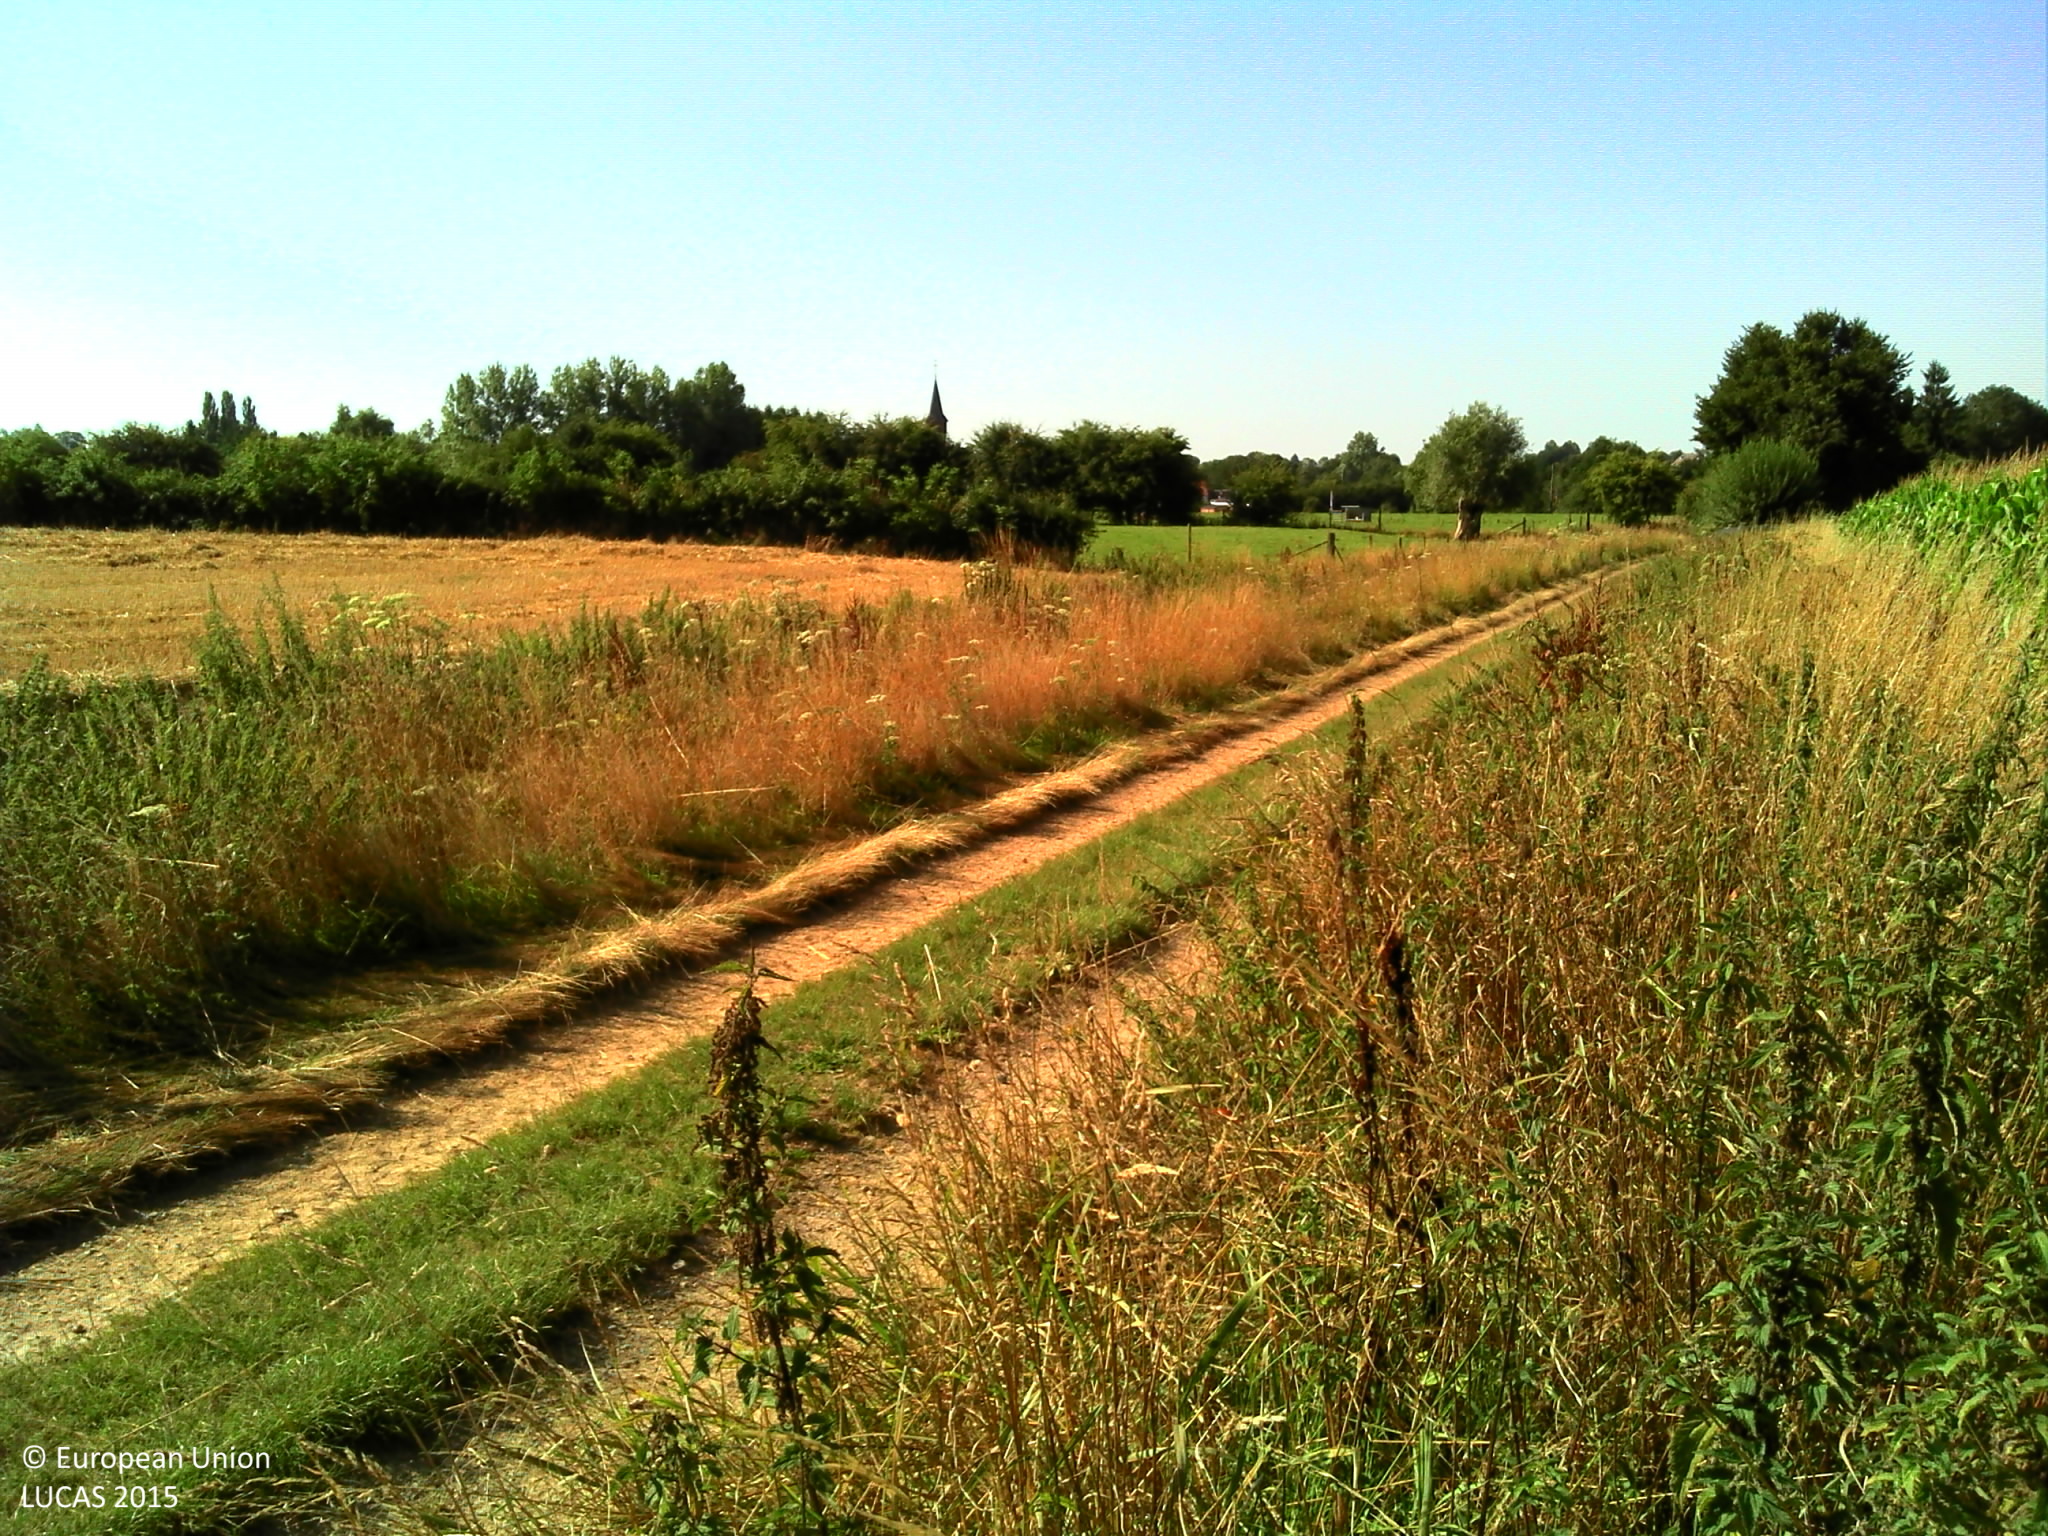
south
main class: Cropland
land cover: Maize
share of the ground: > 75 %
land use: Agriculture (excluding fallow land and kitchen gardens)
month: August
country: FR
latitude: 50.1684
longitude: 3.9601
